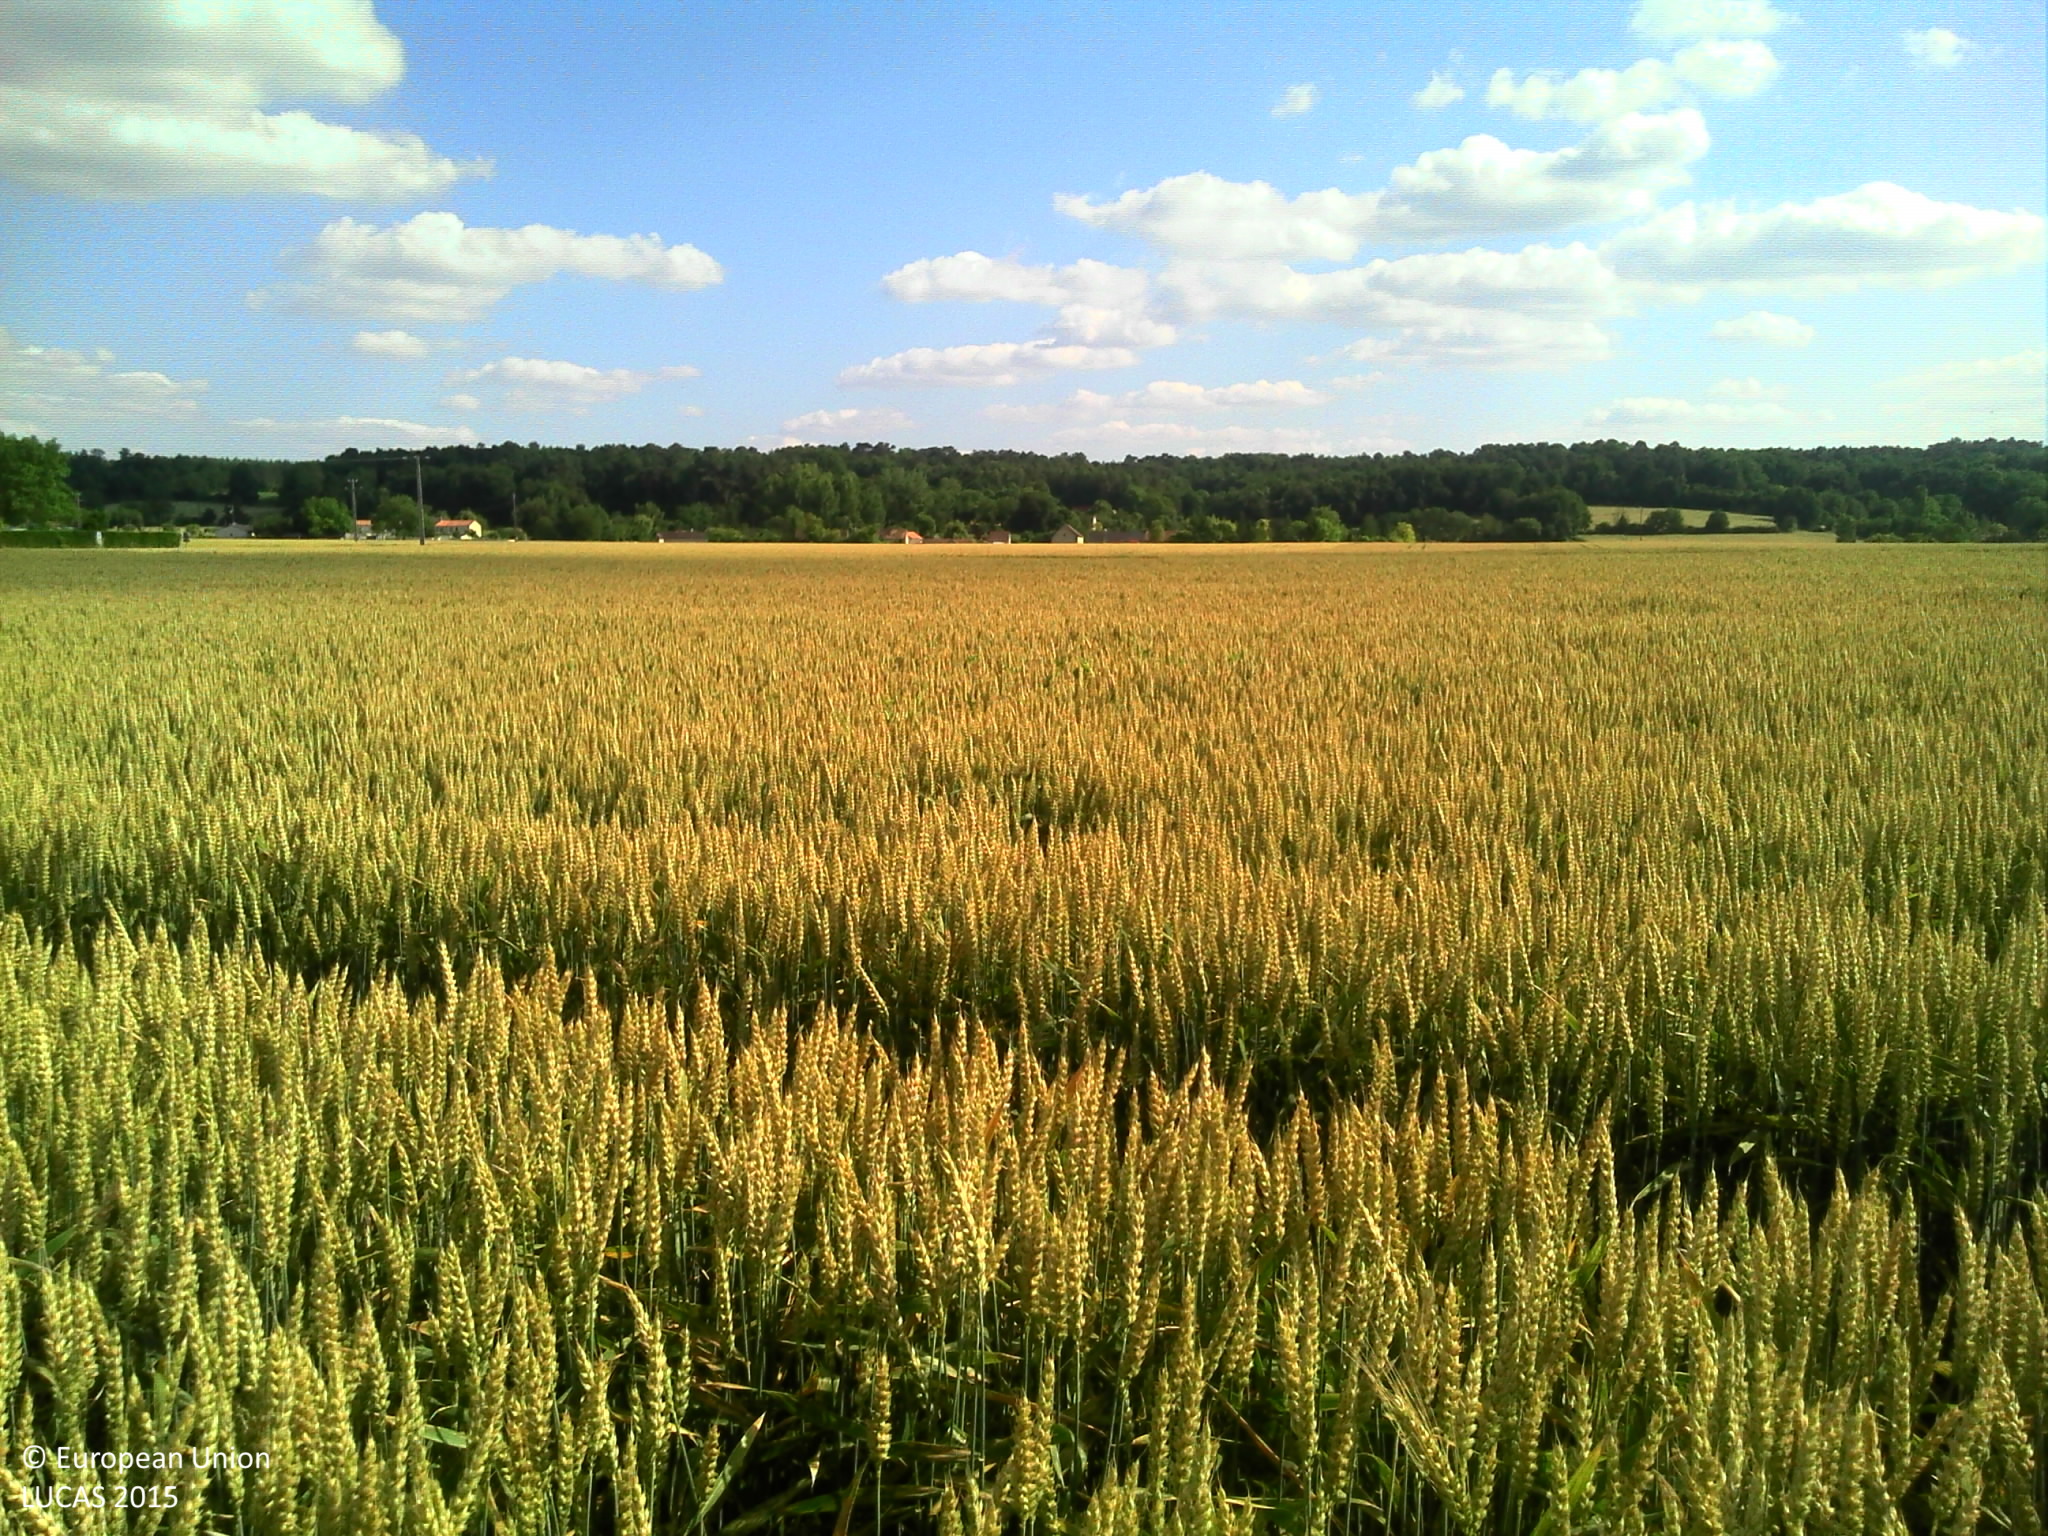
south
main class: Cropland
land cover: Common wheat
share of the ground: > 75 %
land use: Agriculture (excluding fallow land and kitchen gardens)
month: June
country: FR
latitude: 46.7495
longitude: 0.5703
